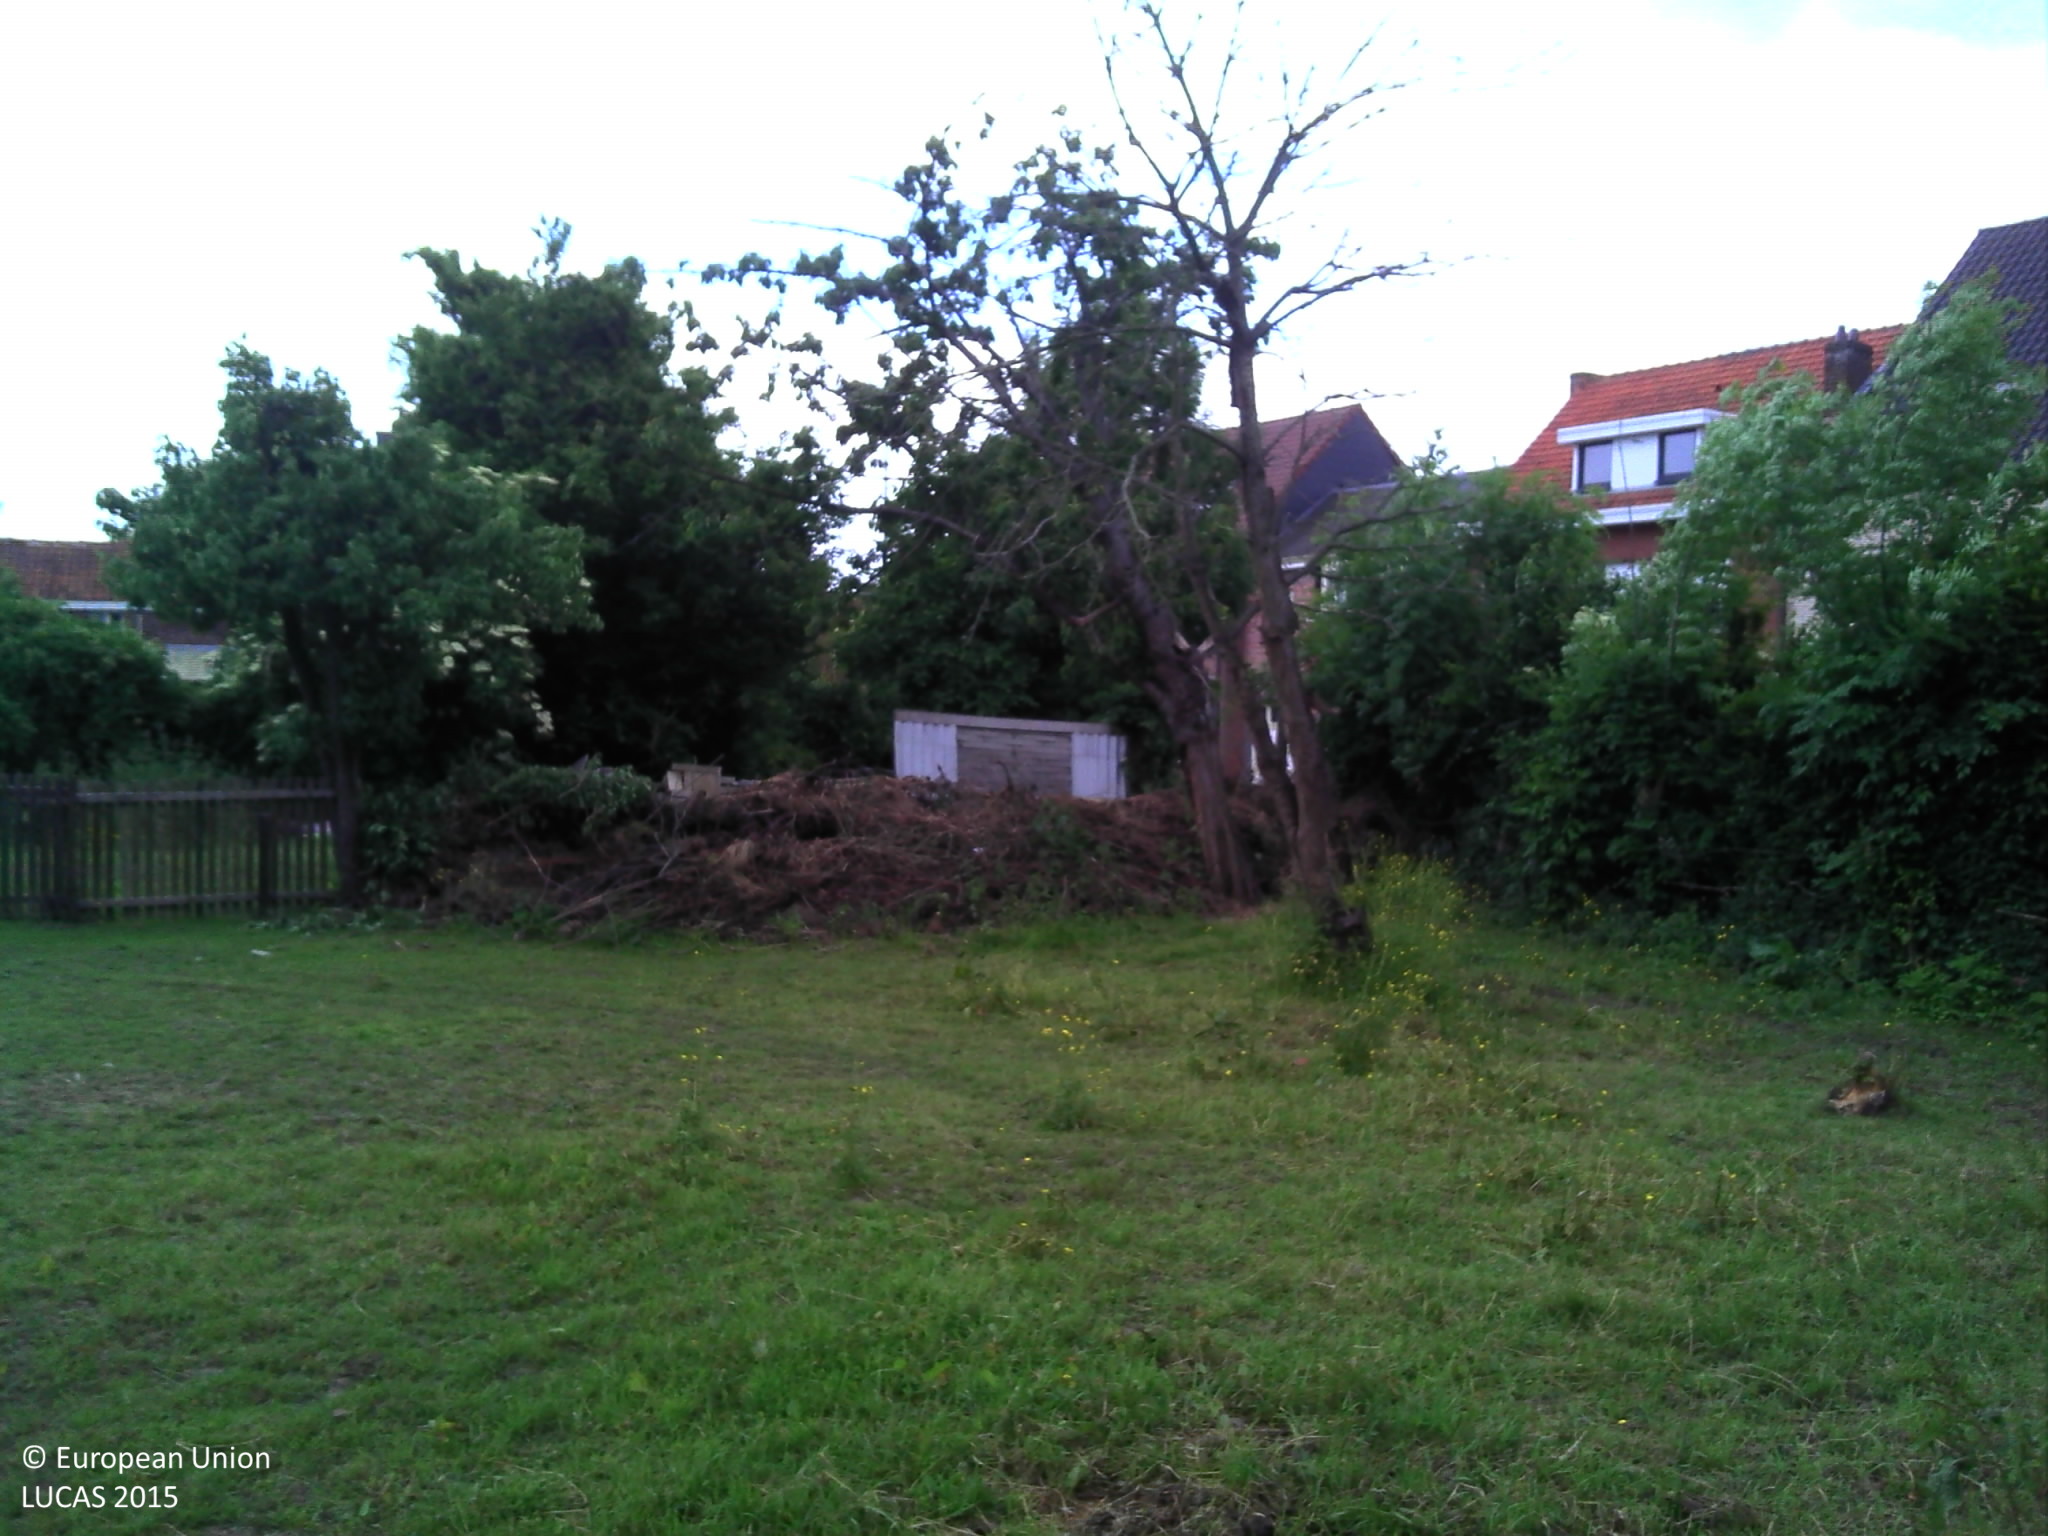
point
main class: Grassland
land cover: Grassland with sparse tree/shrub cover
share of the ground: > 75 %
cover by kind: herbaceous plants 95 %, broadleaved forest trees 5 %
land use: Residential
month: June
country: BE
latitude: 50.9653
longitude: 4.0281
